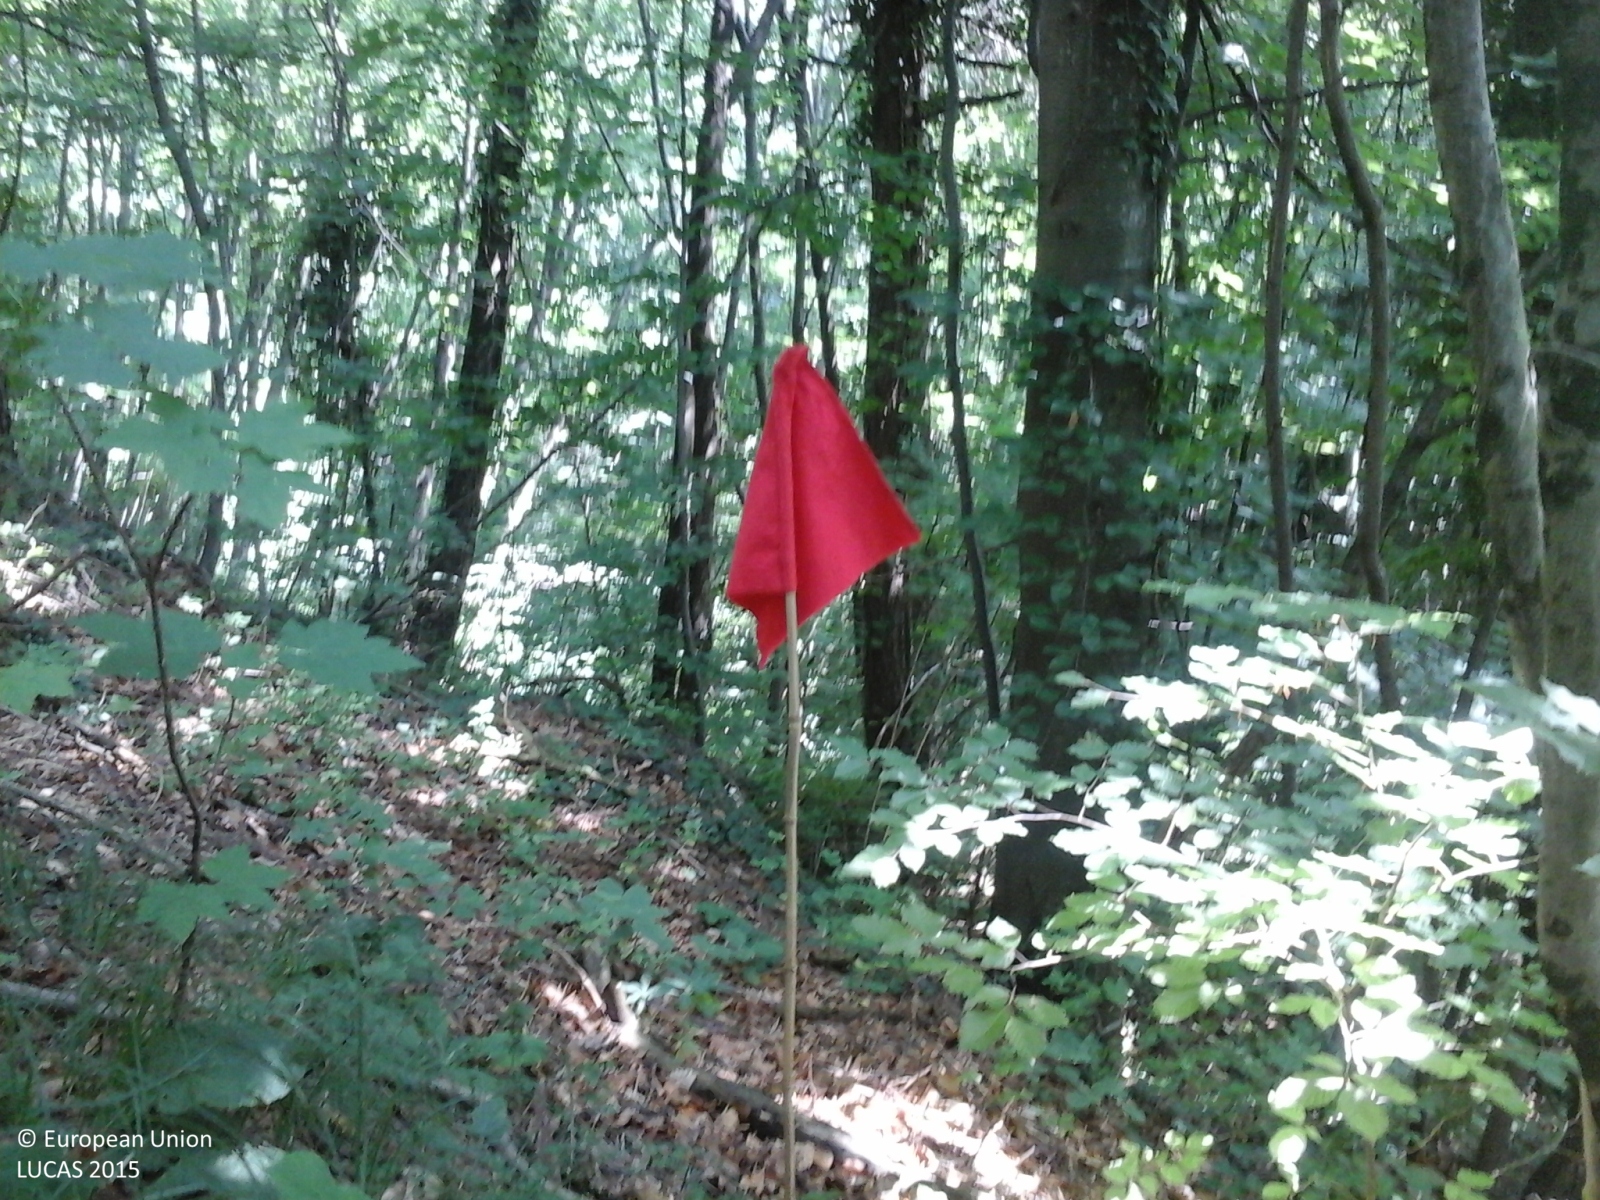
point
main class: Woodland
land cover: Broadleaved woodland
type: thermophilous deciduous forest
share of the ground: > 75 %
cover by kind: broadleaved forest trees 100 %
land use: Forestry
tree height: > 5 m
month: July
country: IT
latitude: 45.5878
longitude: 11.1901
